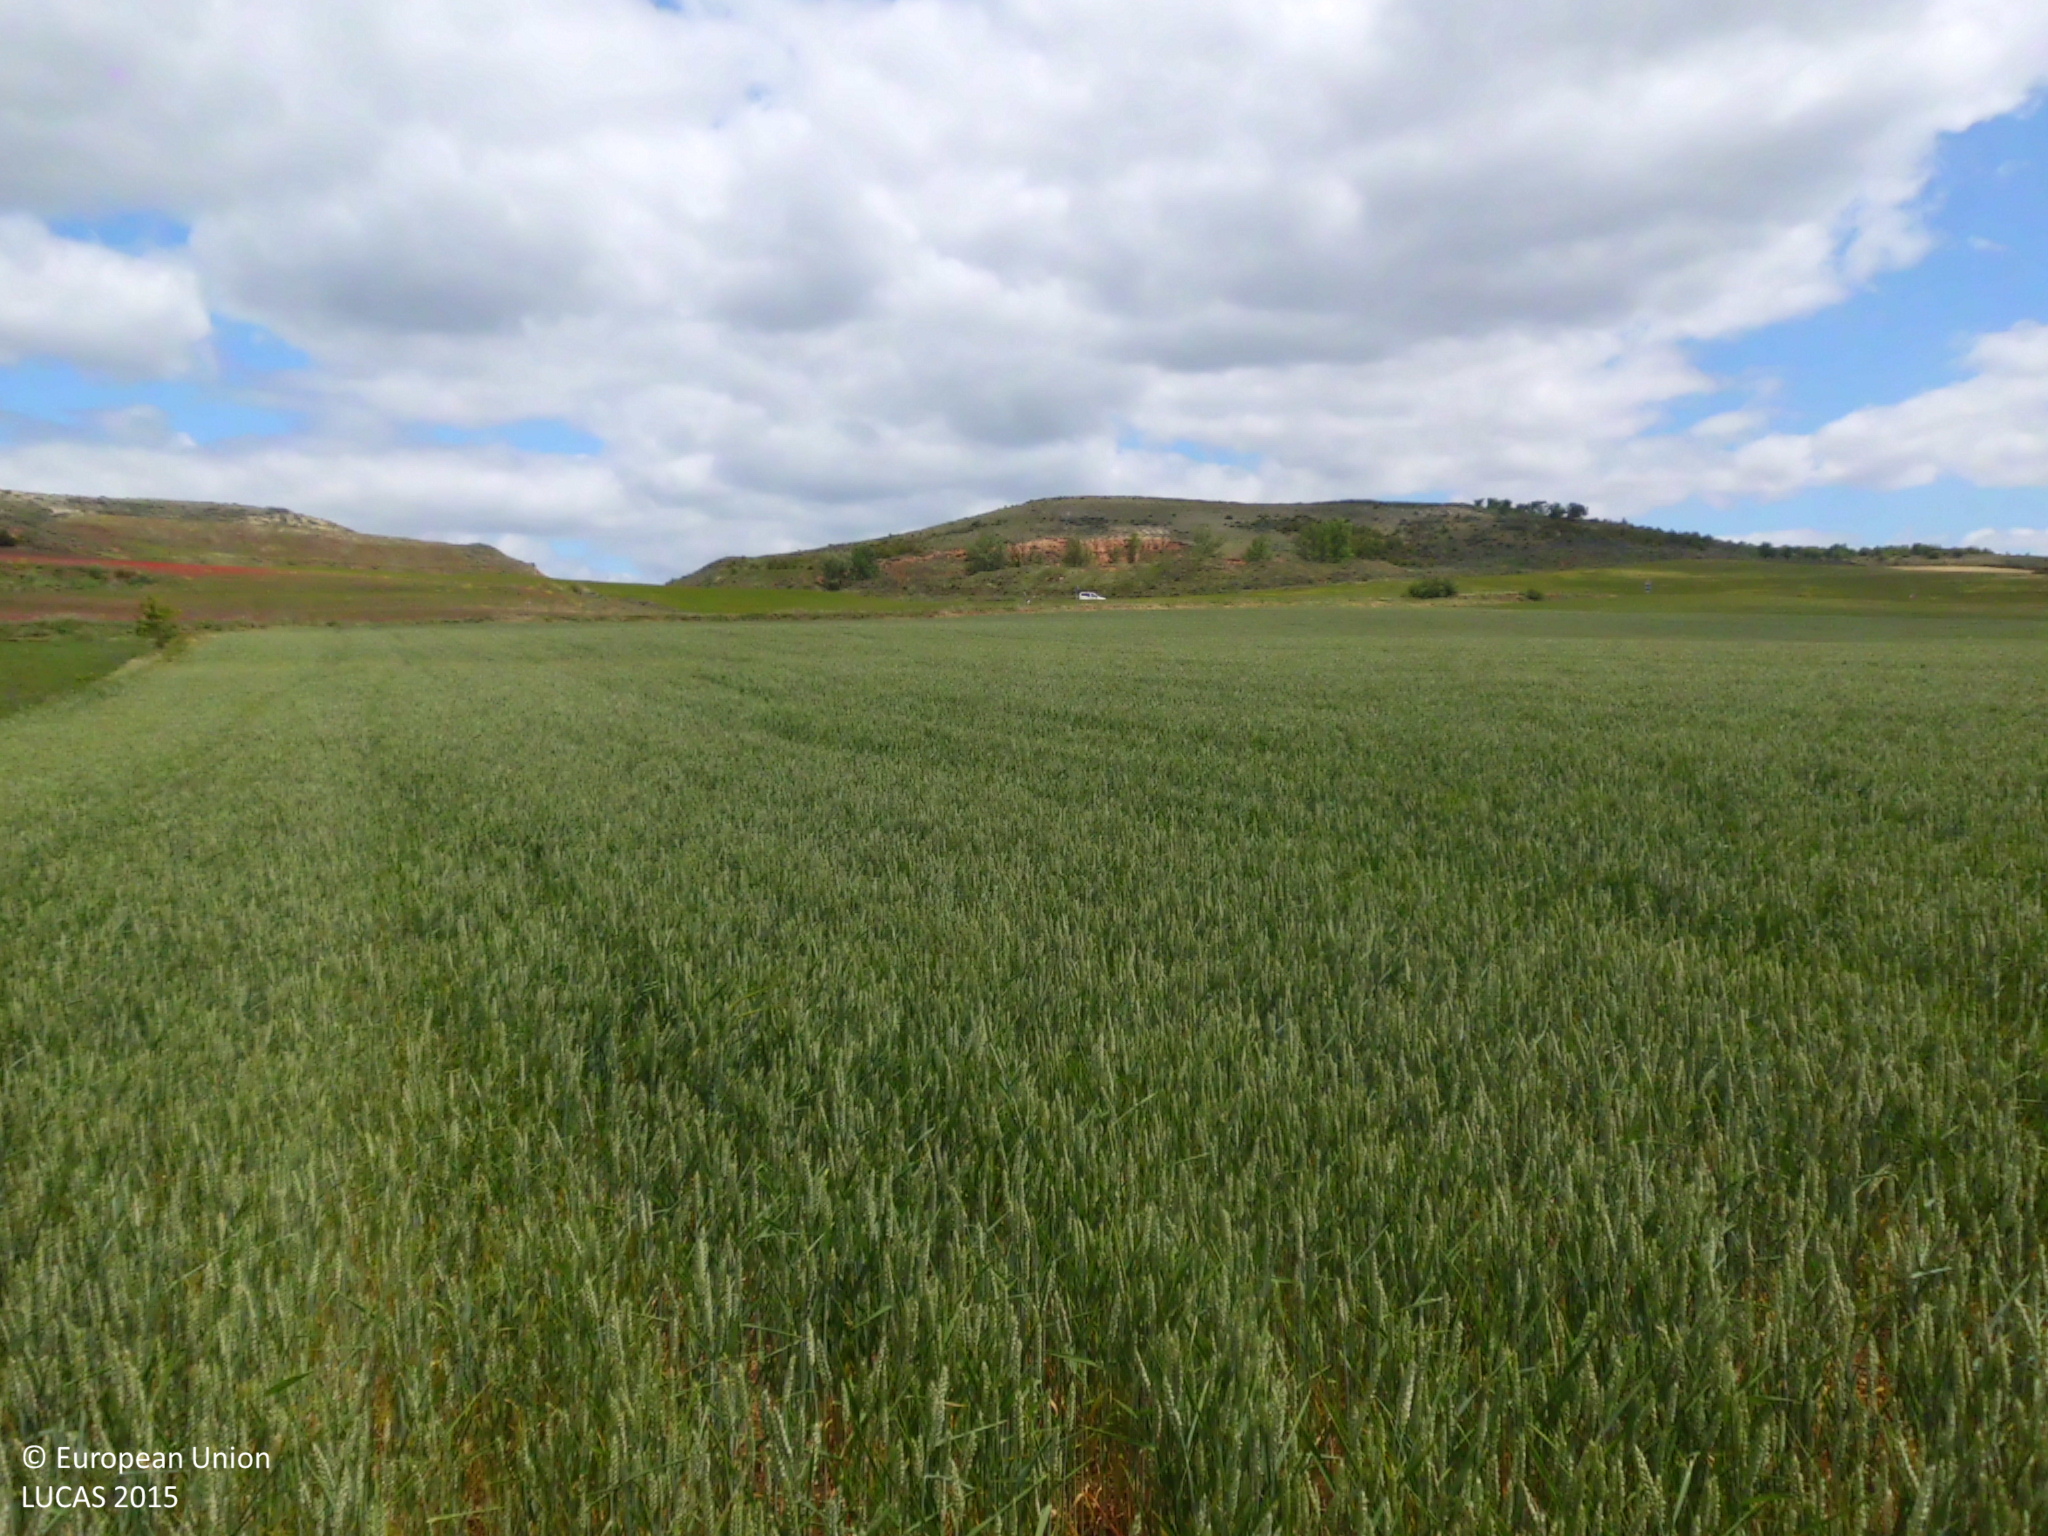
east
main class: Cropland
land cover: Common wheat
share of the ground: > 75 %
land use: Agriculture (excluding fallow land and kitchen gardens)
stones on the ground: 25 - 50 %
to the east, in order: Common wheat; Grass margins; Paved roads, cycling and walking lanes; Grass margins; Common wheat; Barley; Grass margins; Tracks; Grass margins; Barley
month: May
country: ES
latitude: 42.2939
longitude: -3.9020
